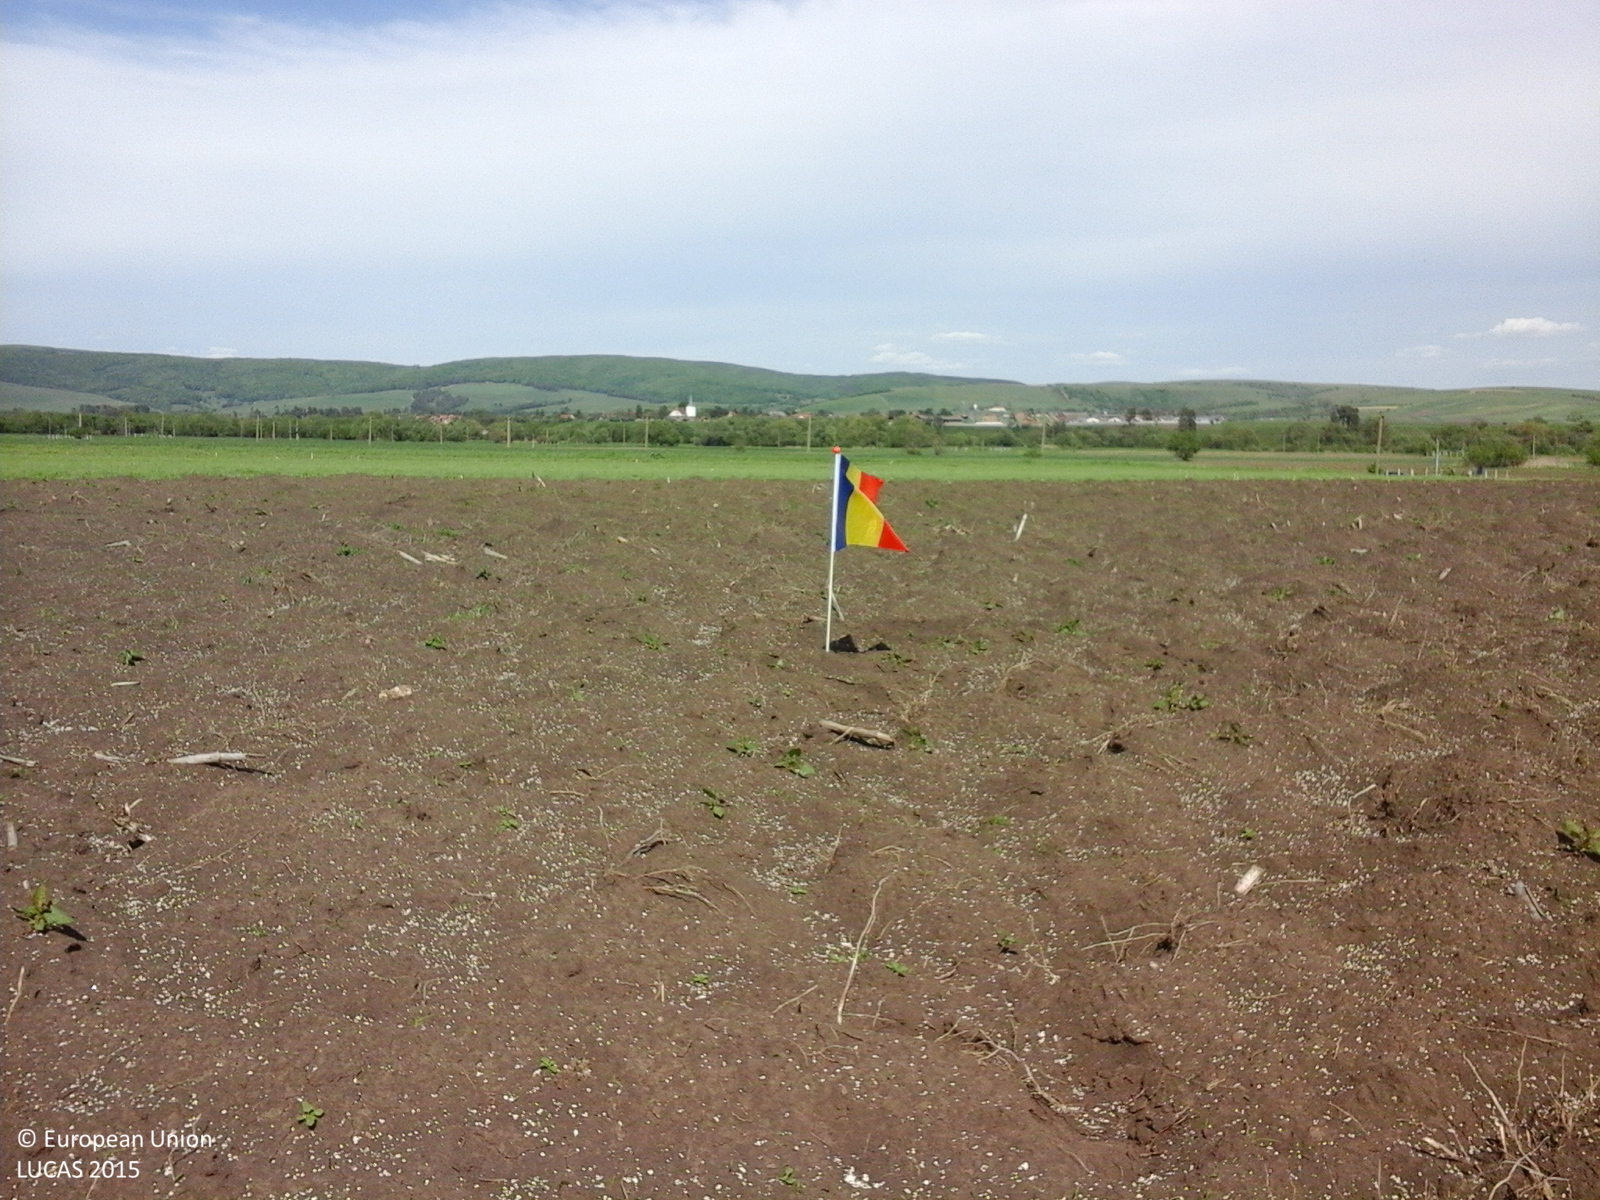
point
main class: Cropland
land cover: Maize
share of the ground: < 10 %
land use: Agriculture (excluding fallow land and kitchen gardens)
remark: Harvested field
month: May
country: RO
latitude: 45.8976
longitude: 25.8231
